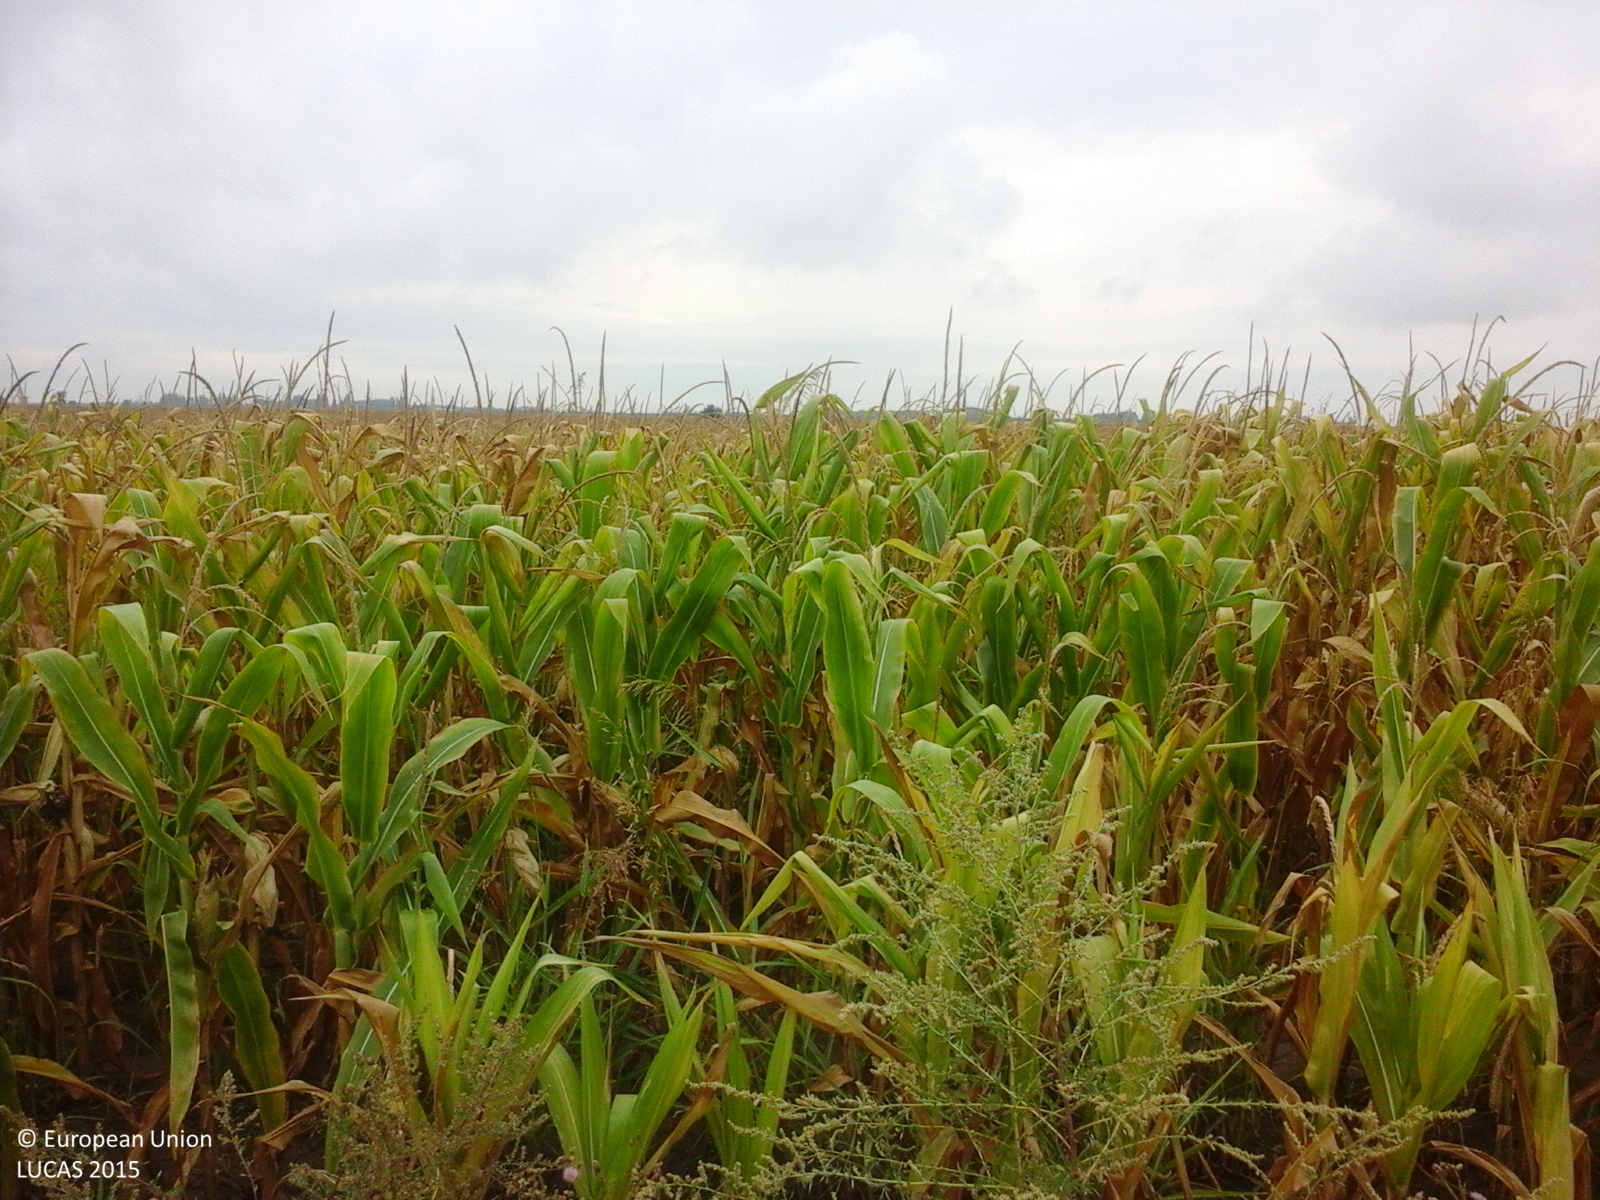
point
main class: Cropland
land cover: Maize
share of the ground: > 75 %
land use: Agriculture (excluding fallow land and kitchen gardens)
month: August
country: RO
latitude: 45.8288
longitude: 20.7228
